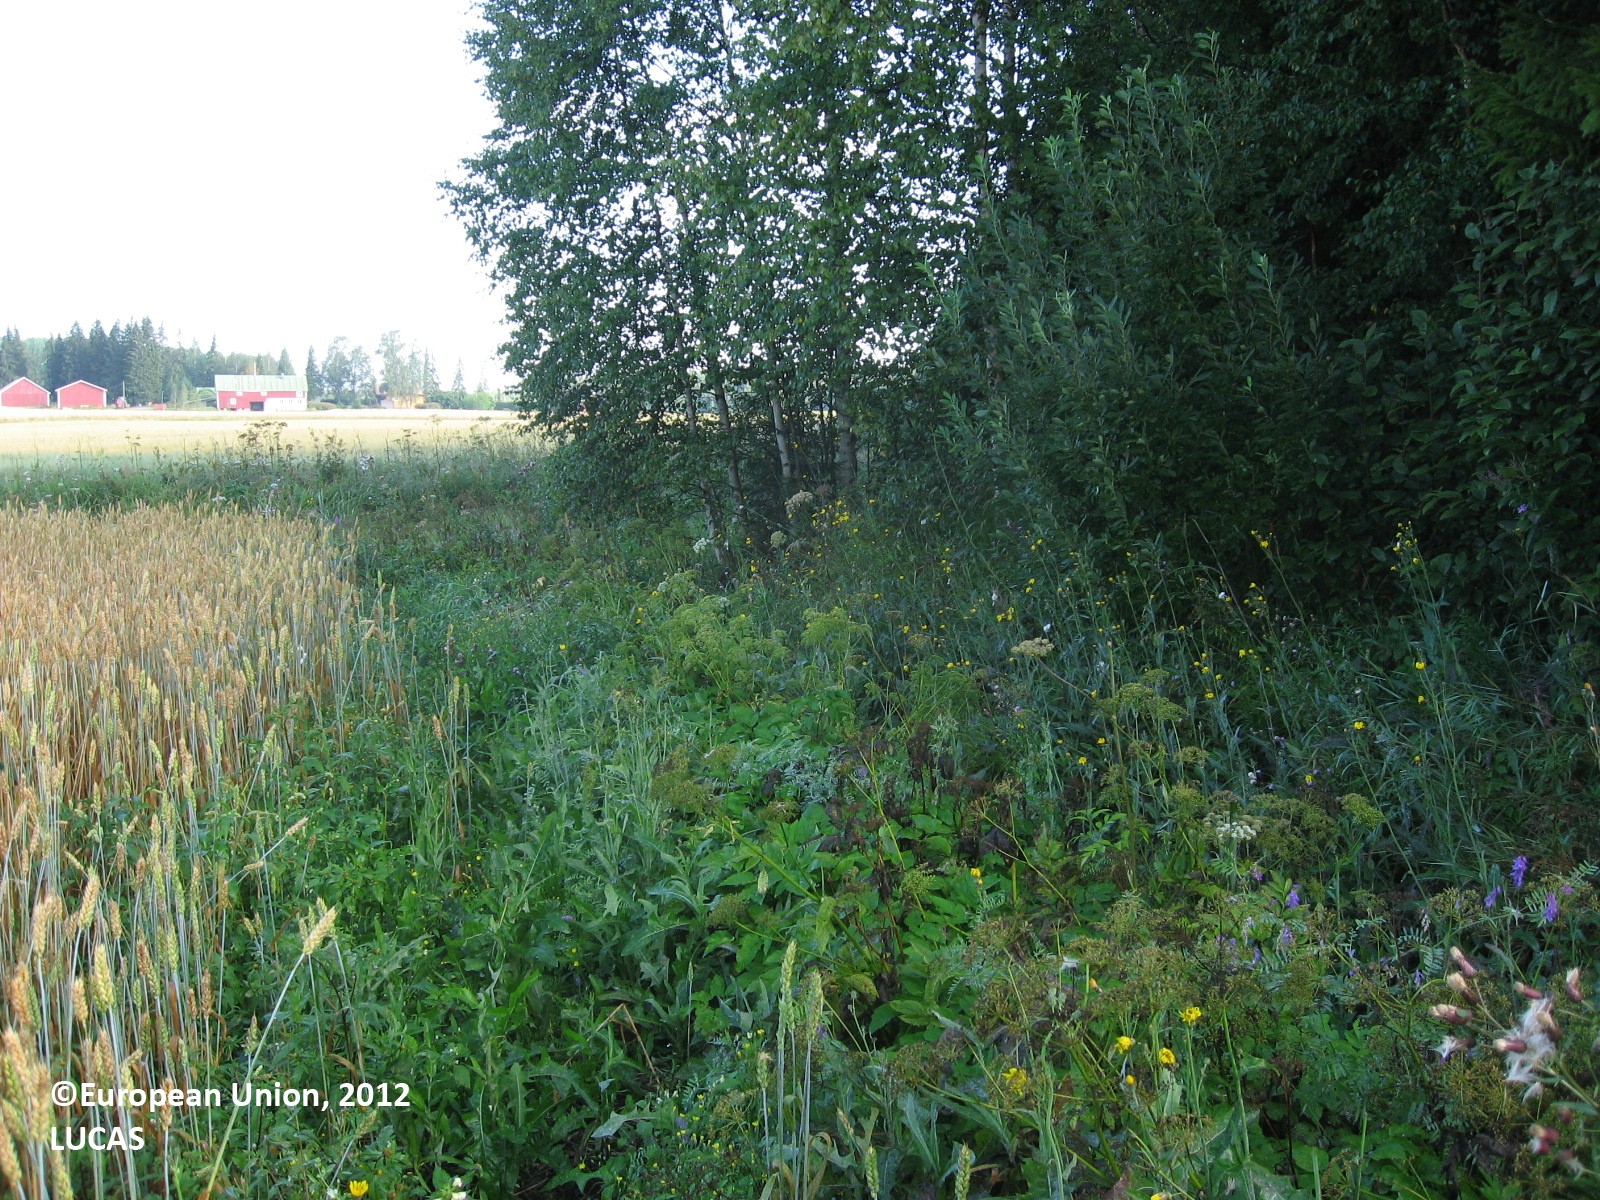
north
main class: Cropland
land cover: Common wheat
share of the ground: > 75 %
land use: Agriculture (excluding fallow land and kitchen gardens)
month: August
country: FI
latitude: 60.6404
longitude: 25.1685
